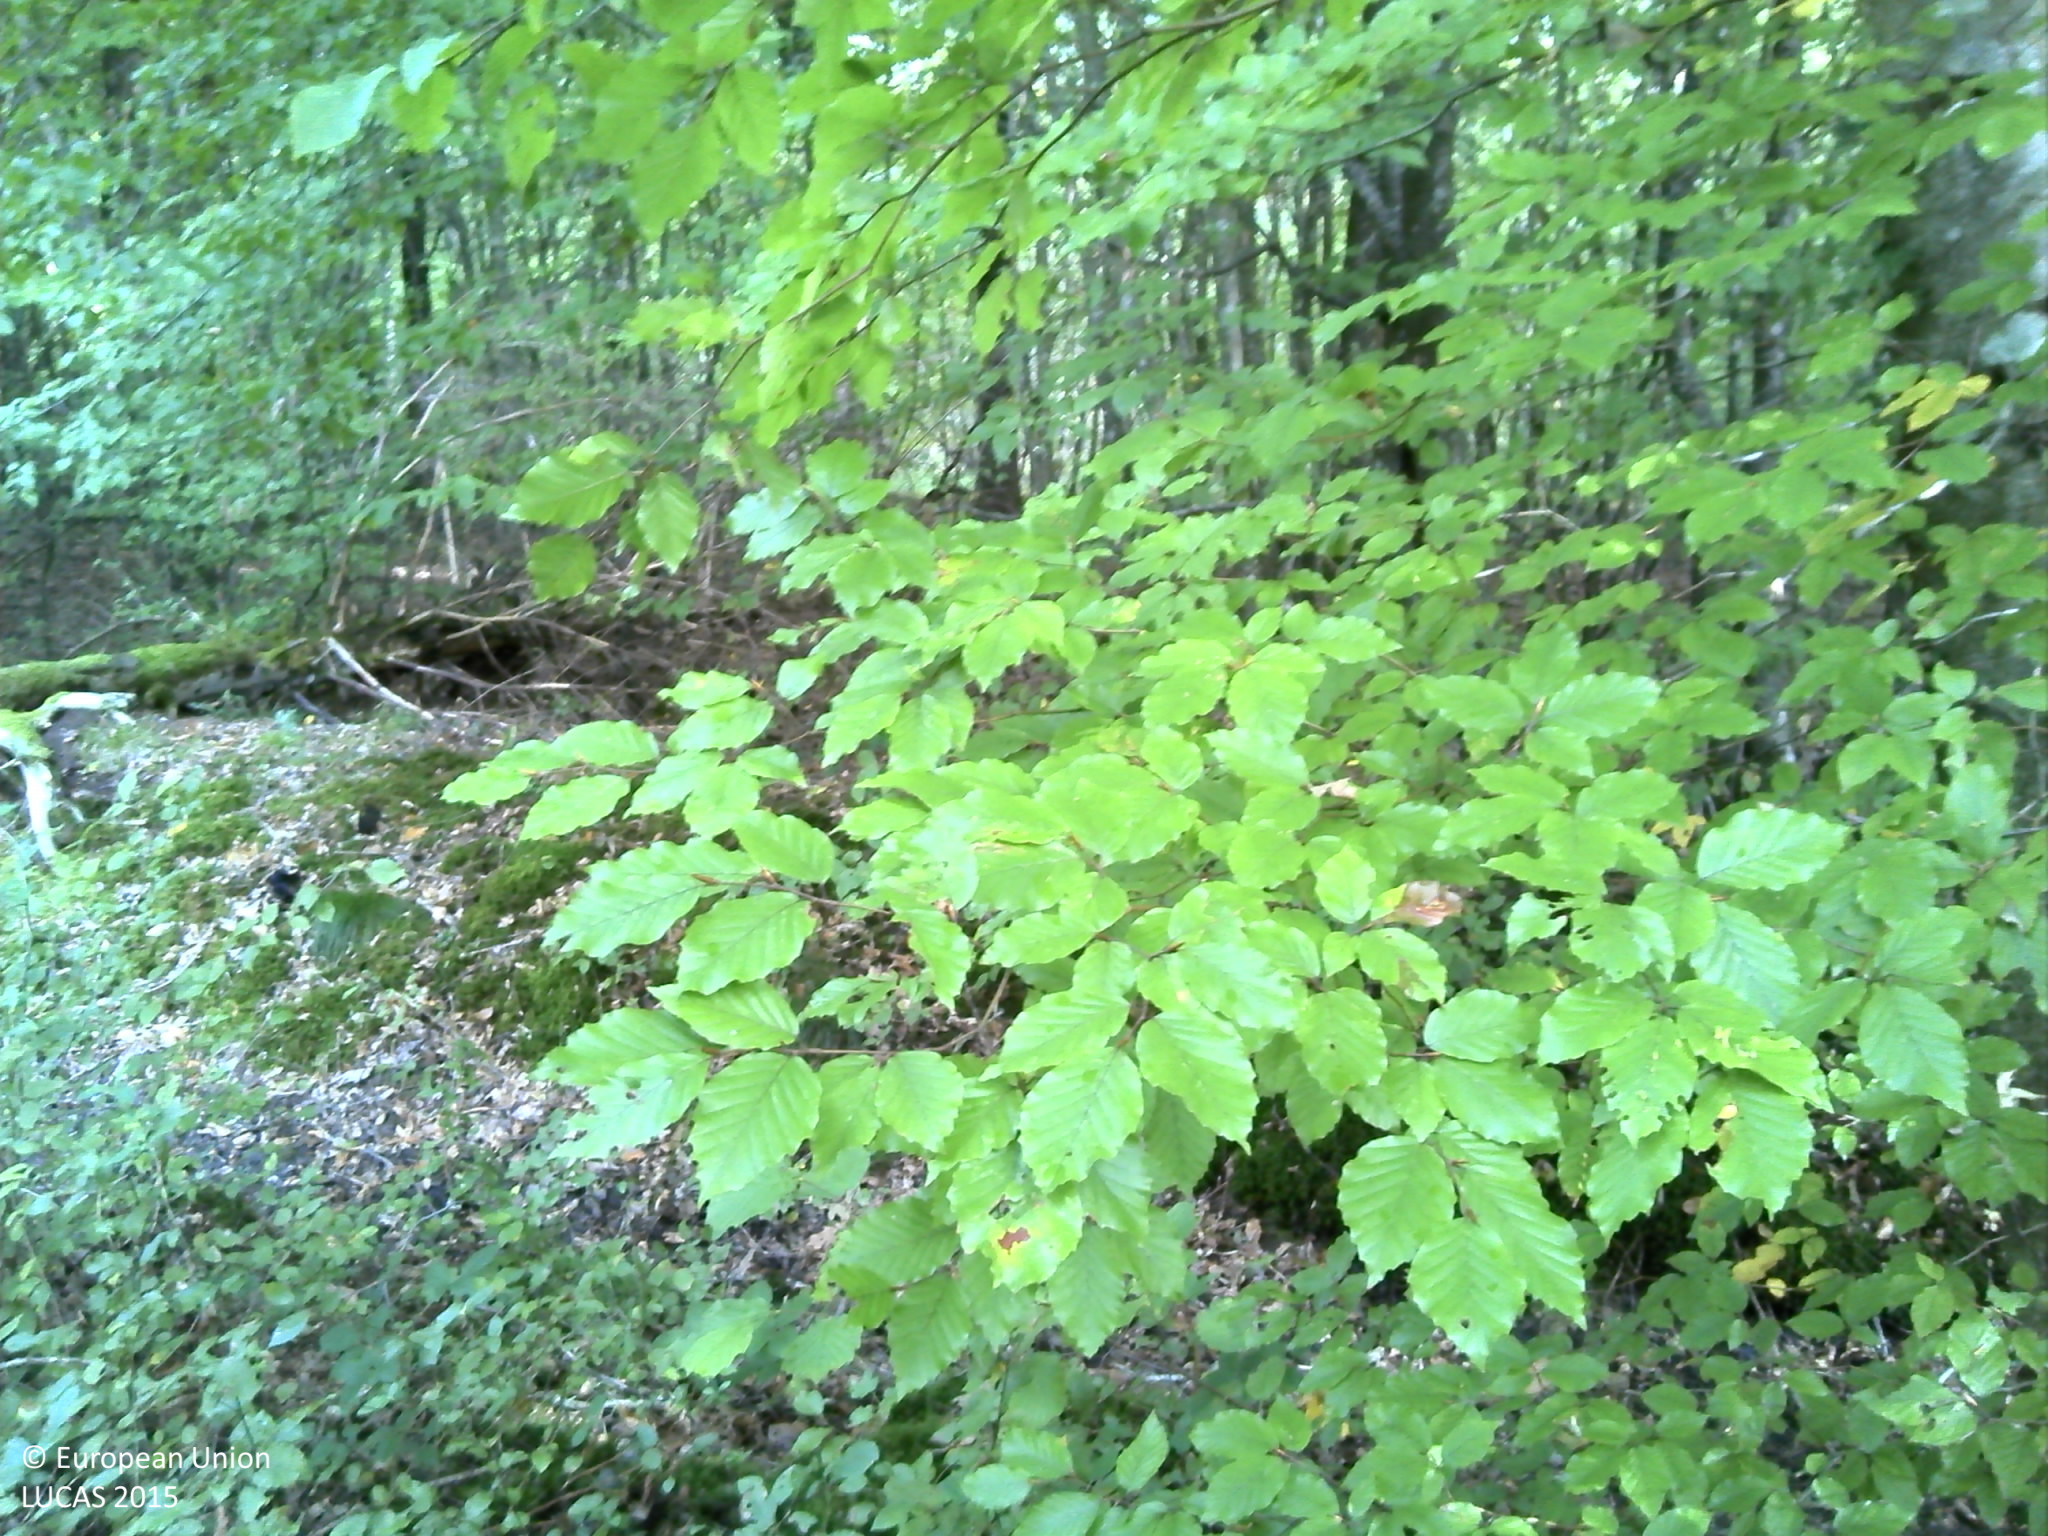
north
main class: Woodland
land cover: Broadleaved woodland
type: acidophilous oak and oak-birch forest
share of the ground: > 75 %
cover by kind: broadleaved forest trees 85 %, herbaceous plants 15 %
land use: Forestry
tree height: > 5 m
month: June
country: FR
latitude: 46.6919
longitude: 4.7577
